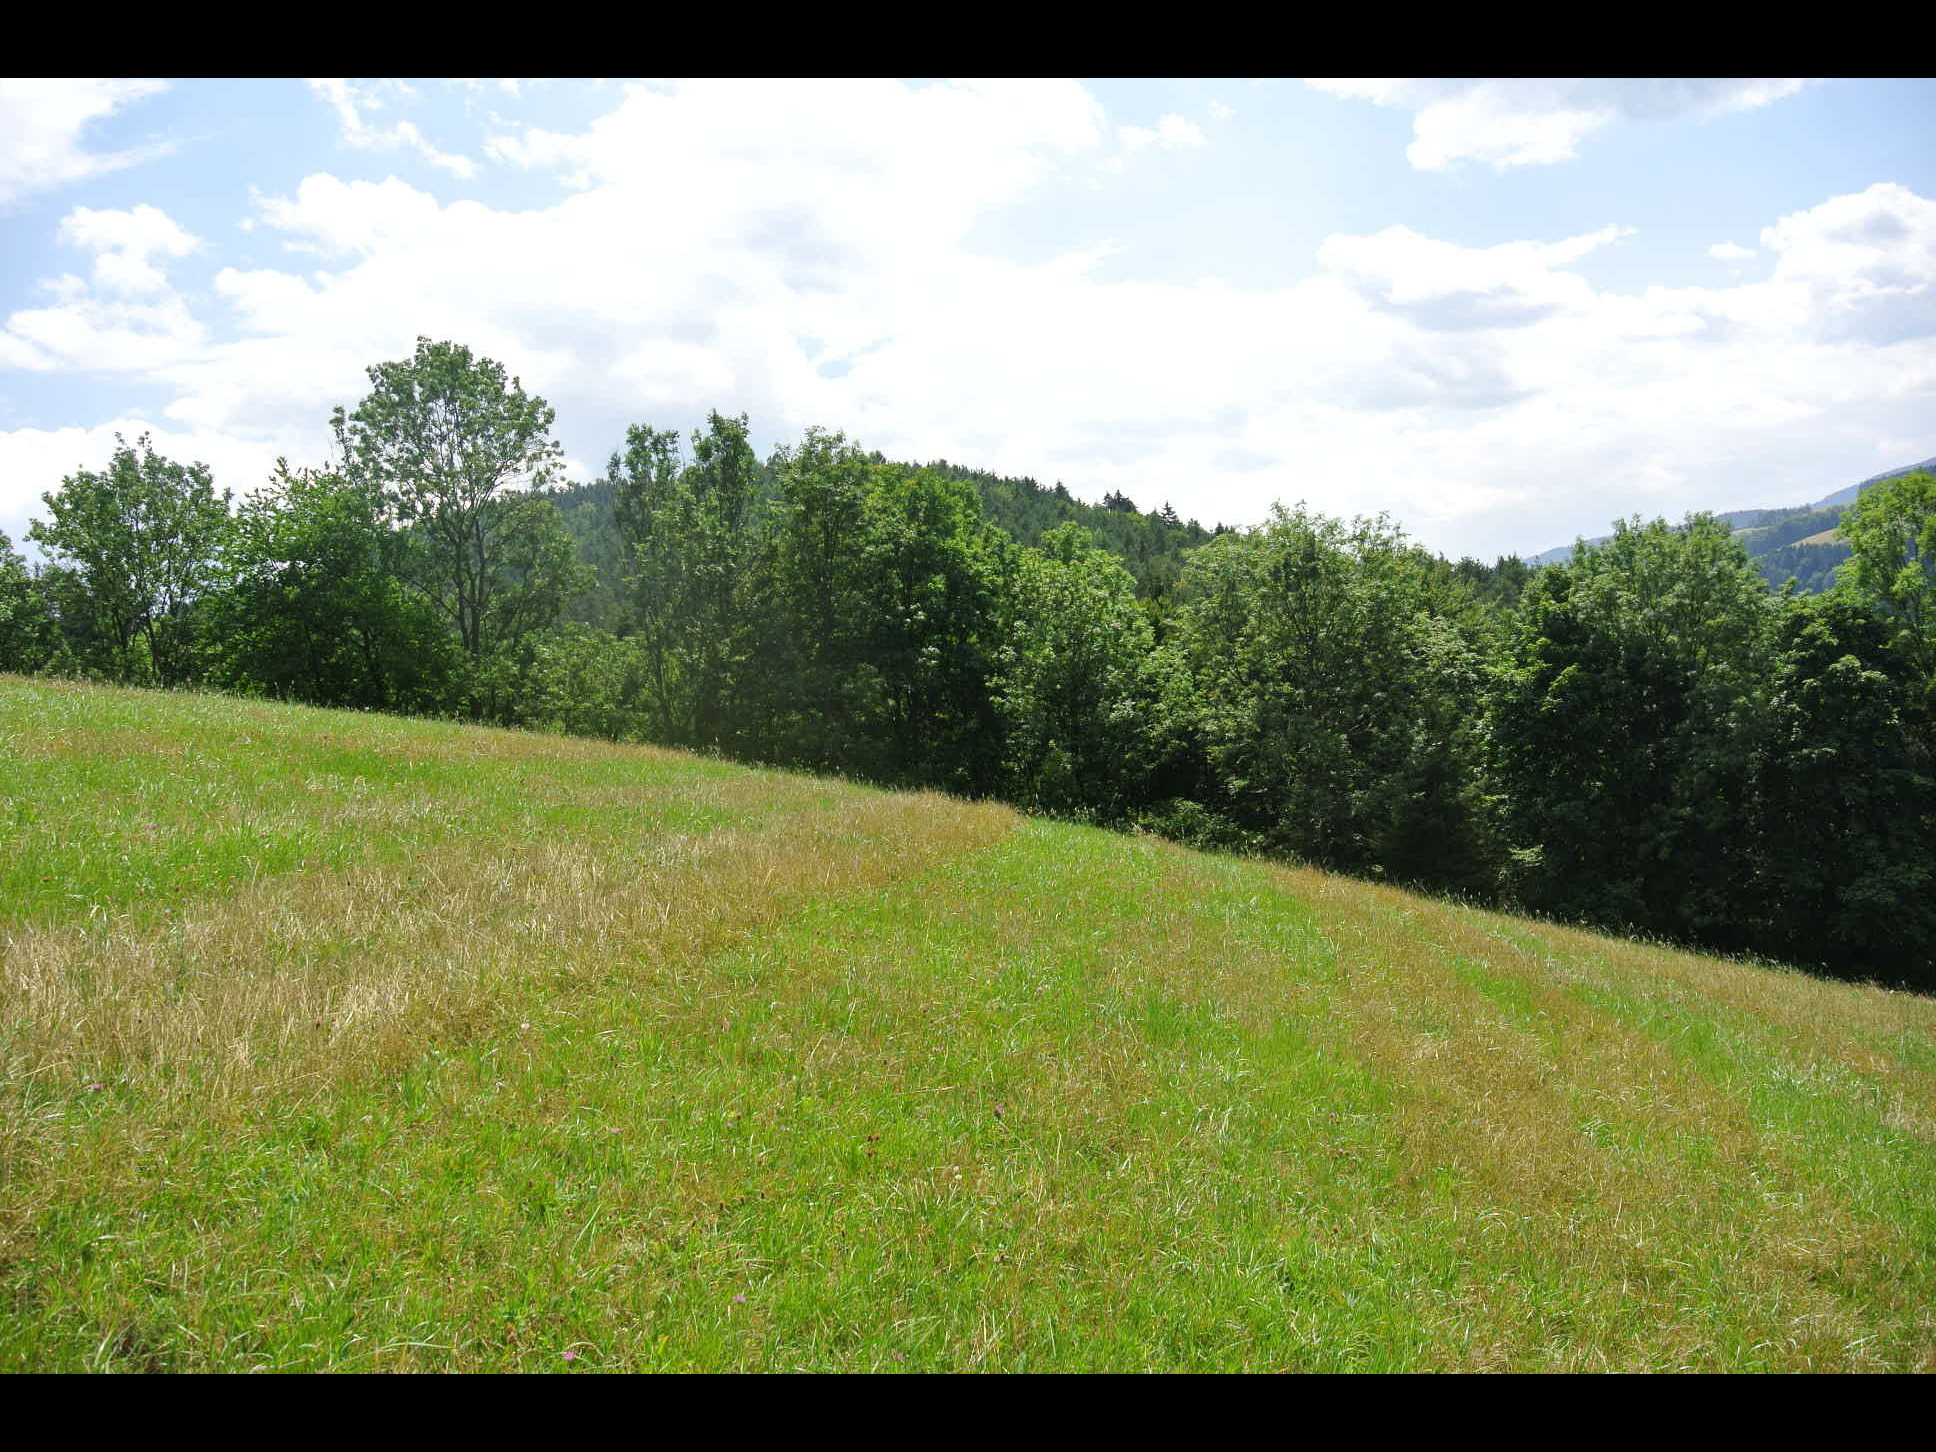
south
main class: Grassland
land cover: Grassland without tree/shrub cover
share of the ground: > 75 %
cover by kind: herbaceous plants 100 %
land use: Agriculture (excluding fallow land and kitchen gardens)
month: July
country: AT
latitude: 47.5851
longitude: 16.1059
